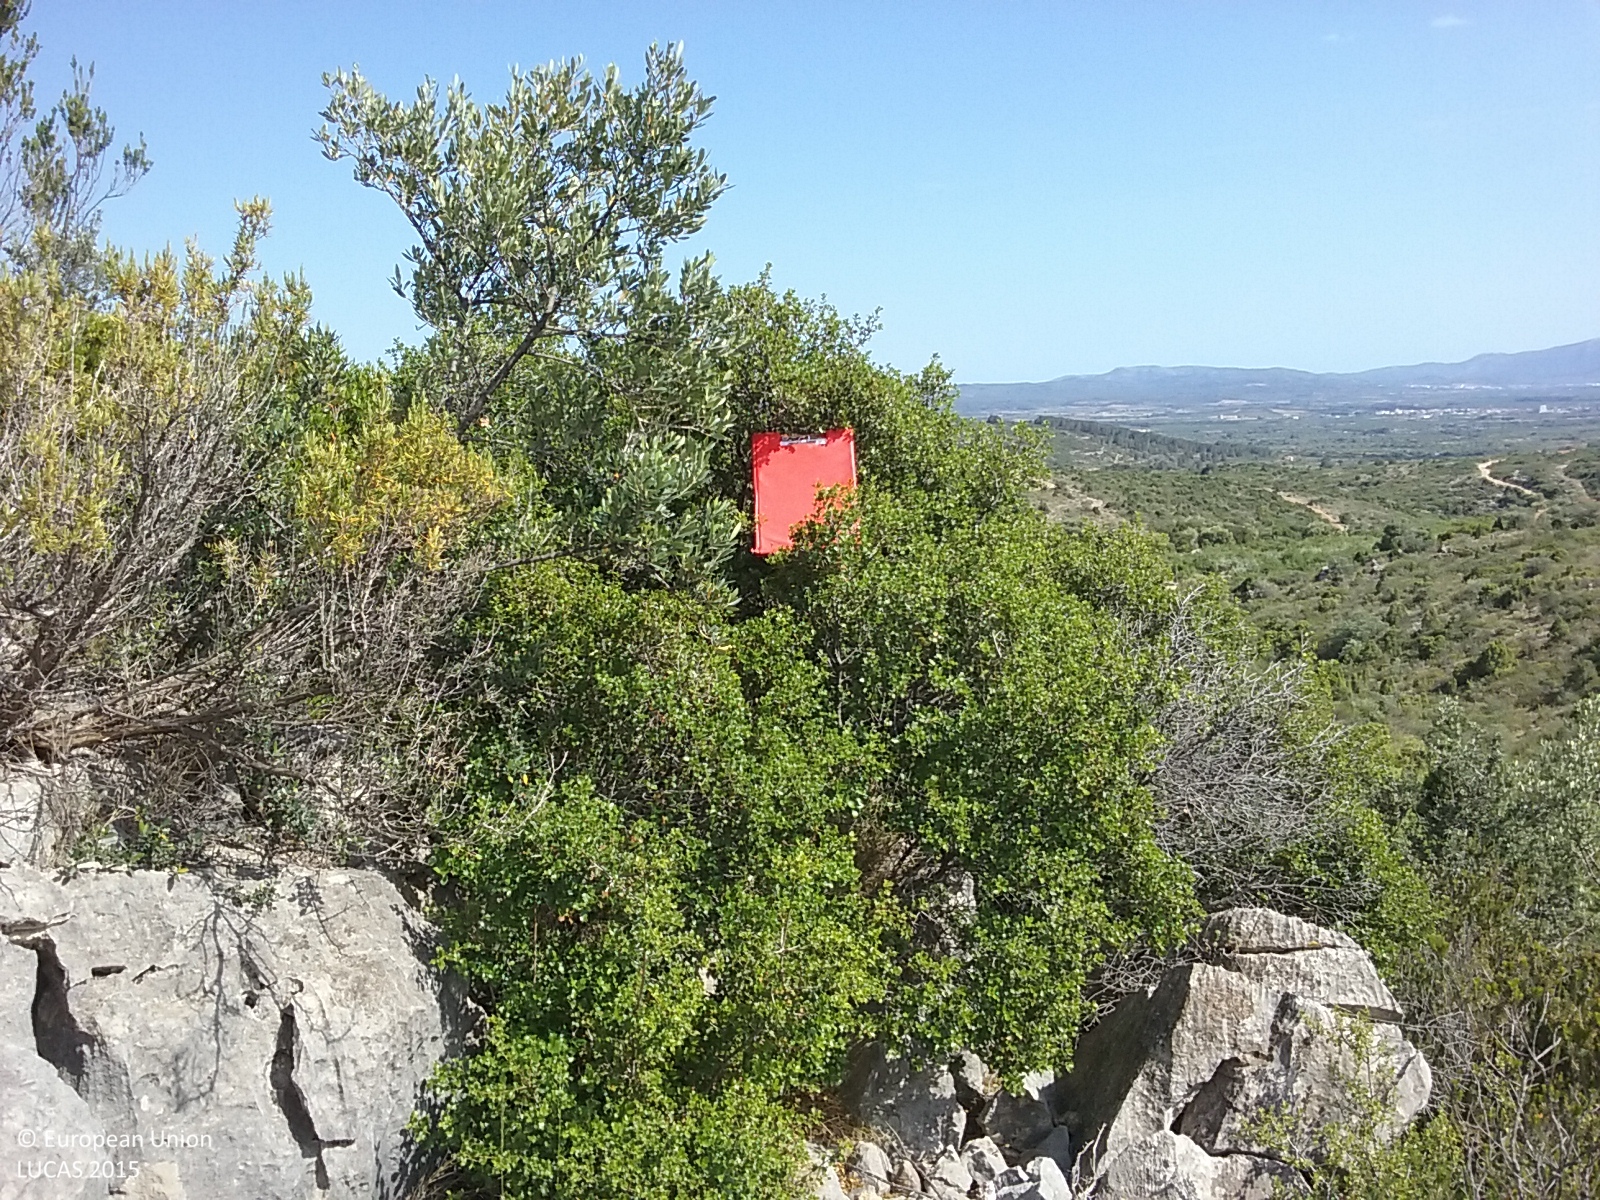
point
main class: Shrubland
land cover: Shrubland with sparse tree cover
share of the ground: > 75 %
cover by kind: shrubs 70 %, herbaceous plants 20 %, broadleaved forest trees 5 %
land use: Semi-natural and natural areas not in use
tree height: < 5 m
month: May
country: ES
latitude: 40.2666
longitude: 0.0131
